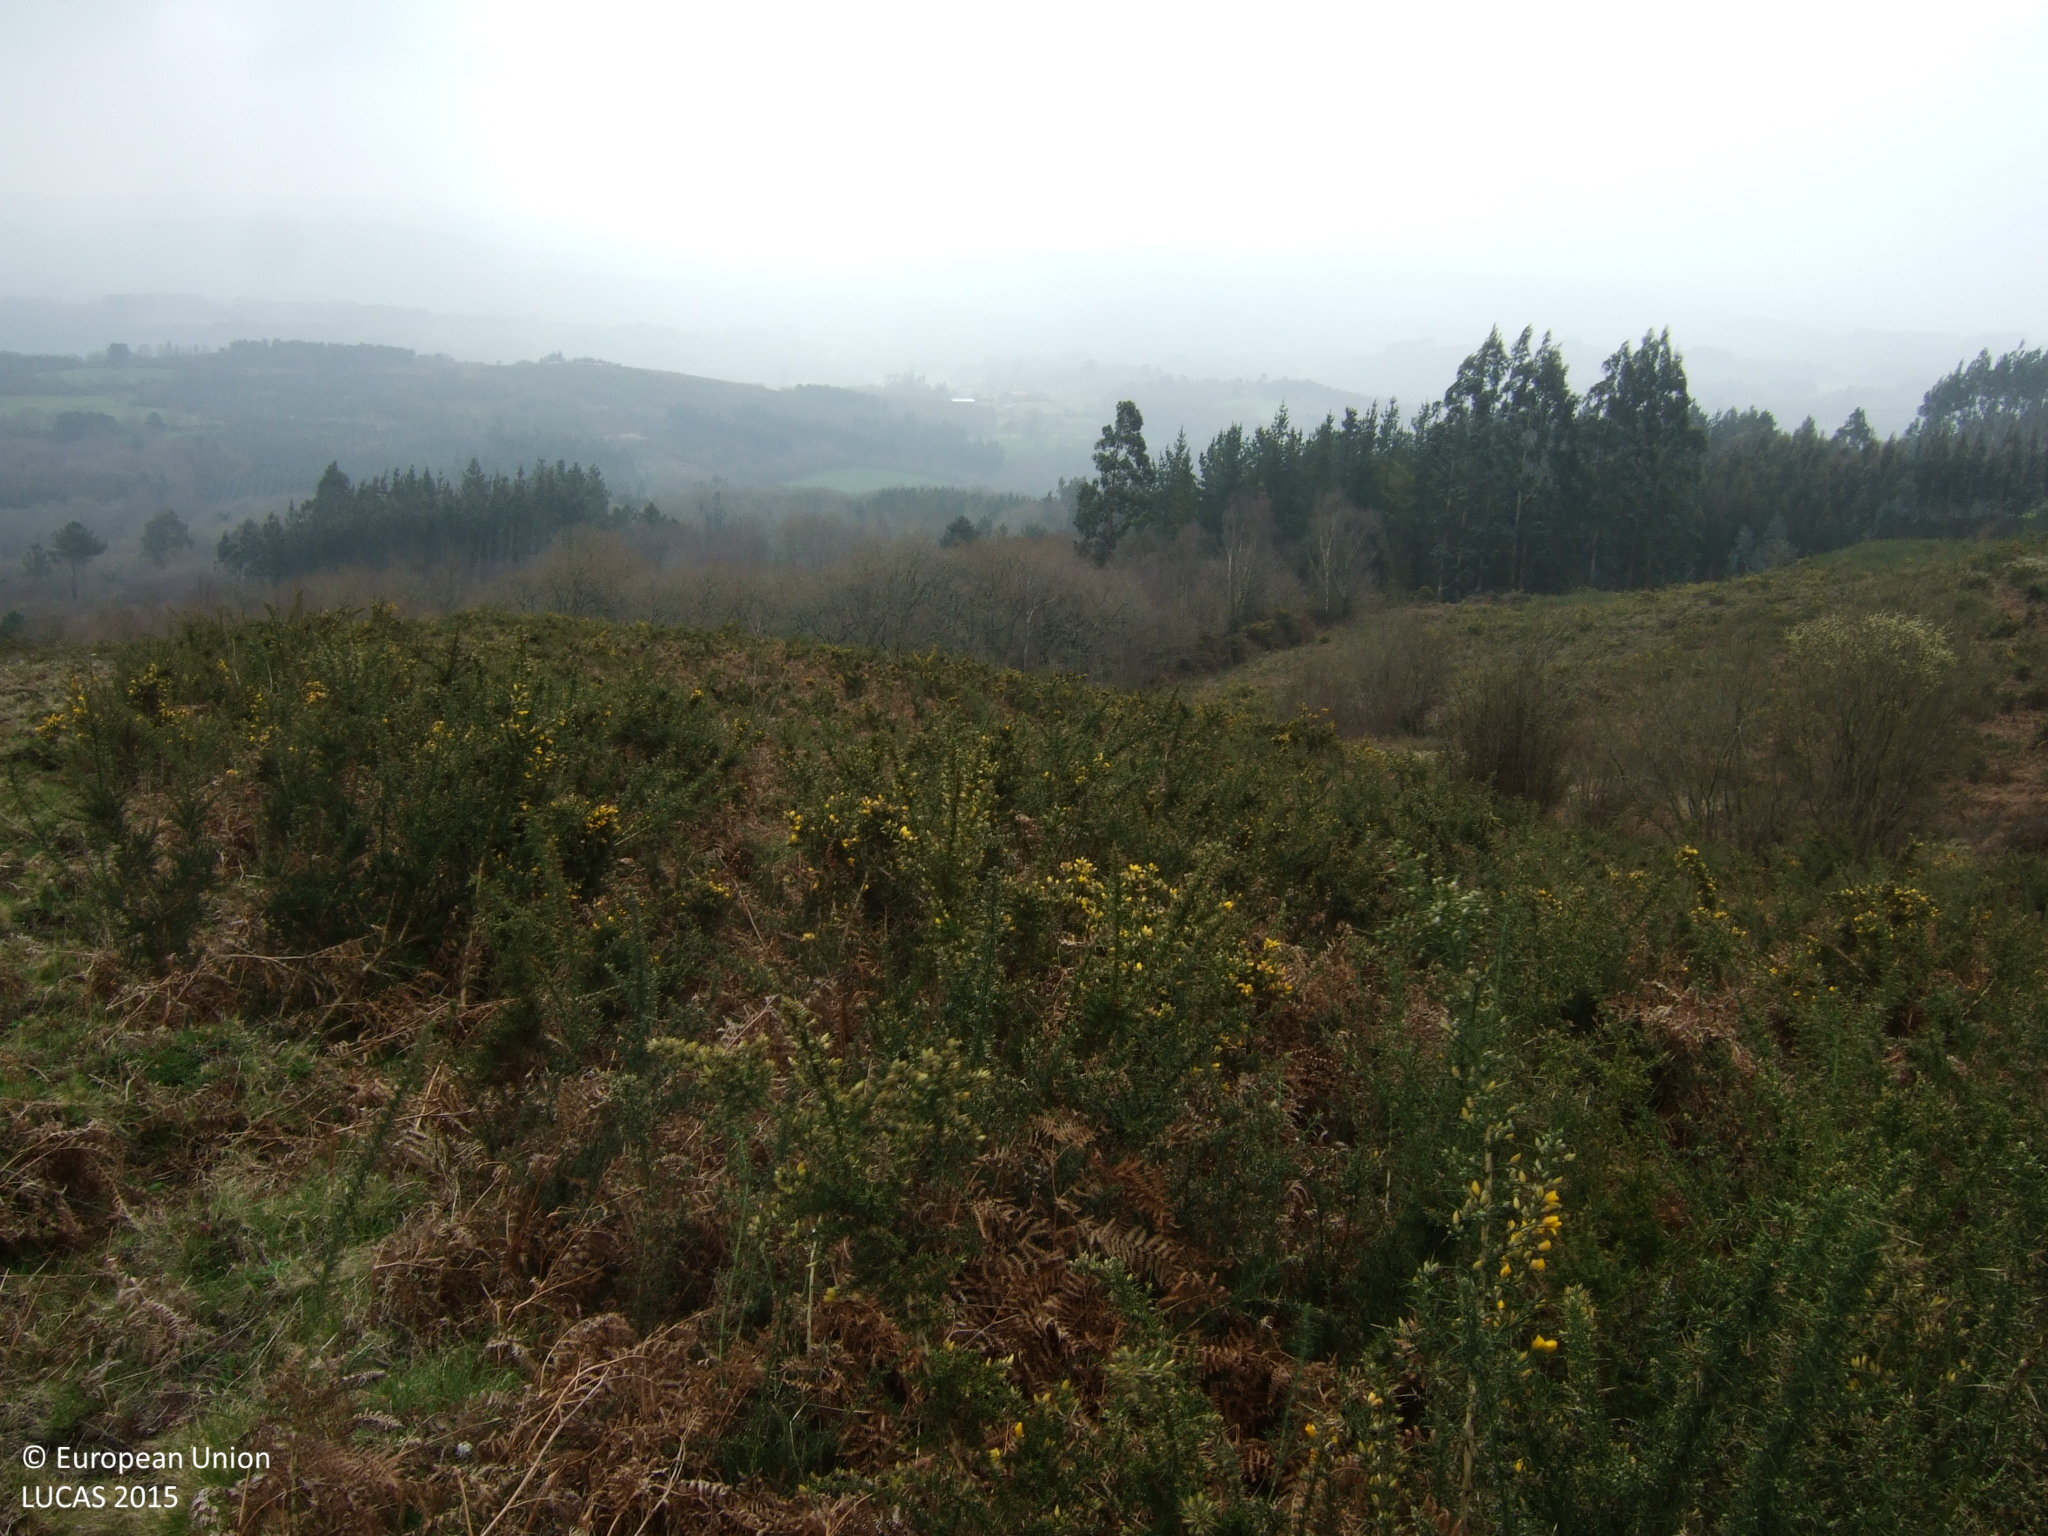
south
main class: Shrubland
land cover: Shrubland without tree cover
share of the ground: > 75 %
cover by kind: shrubs 100 %
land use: Abandoned areas
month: March
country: ES
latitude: 42.9455
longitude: -7.8938
